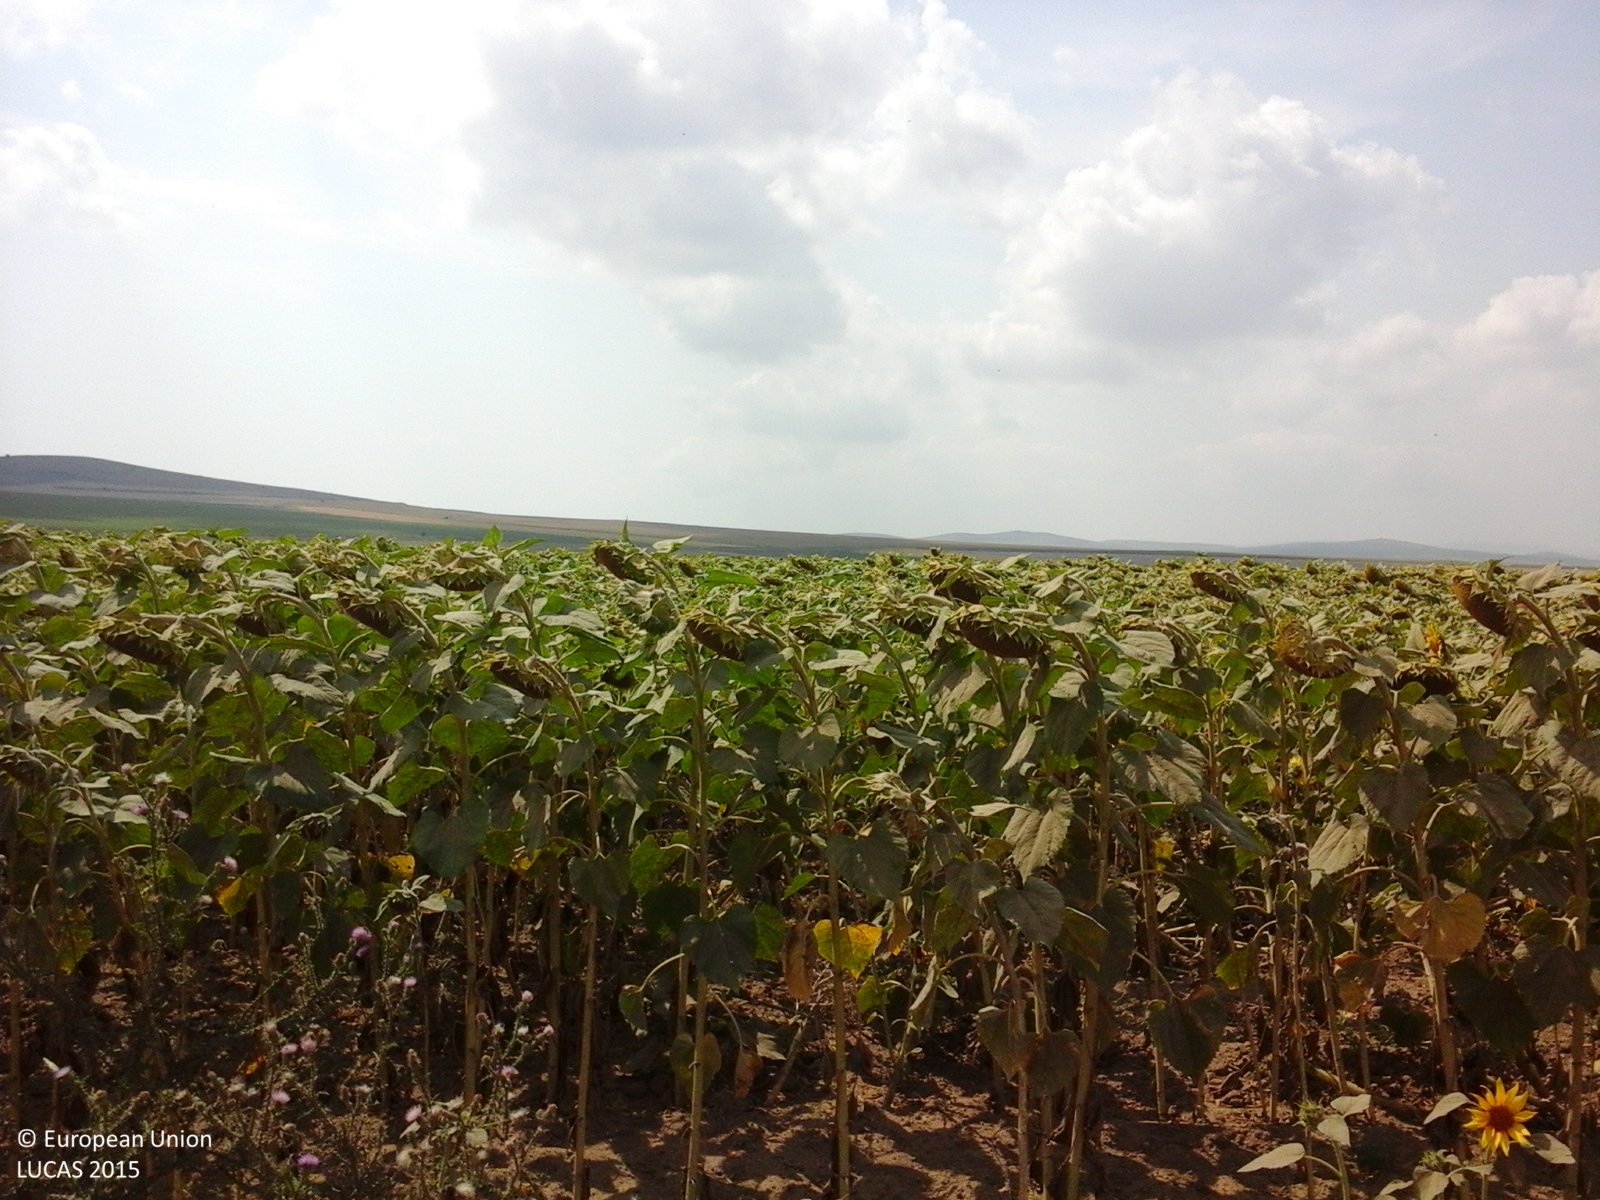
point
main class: Cropland
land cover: Sunflower
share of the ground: > 75 %
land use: Agriculture (excluding fallow land and kitchen gardens)
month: July
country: RO
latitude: 45.0410
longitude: 28.7615
